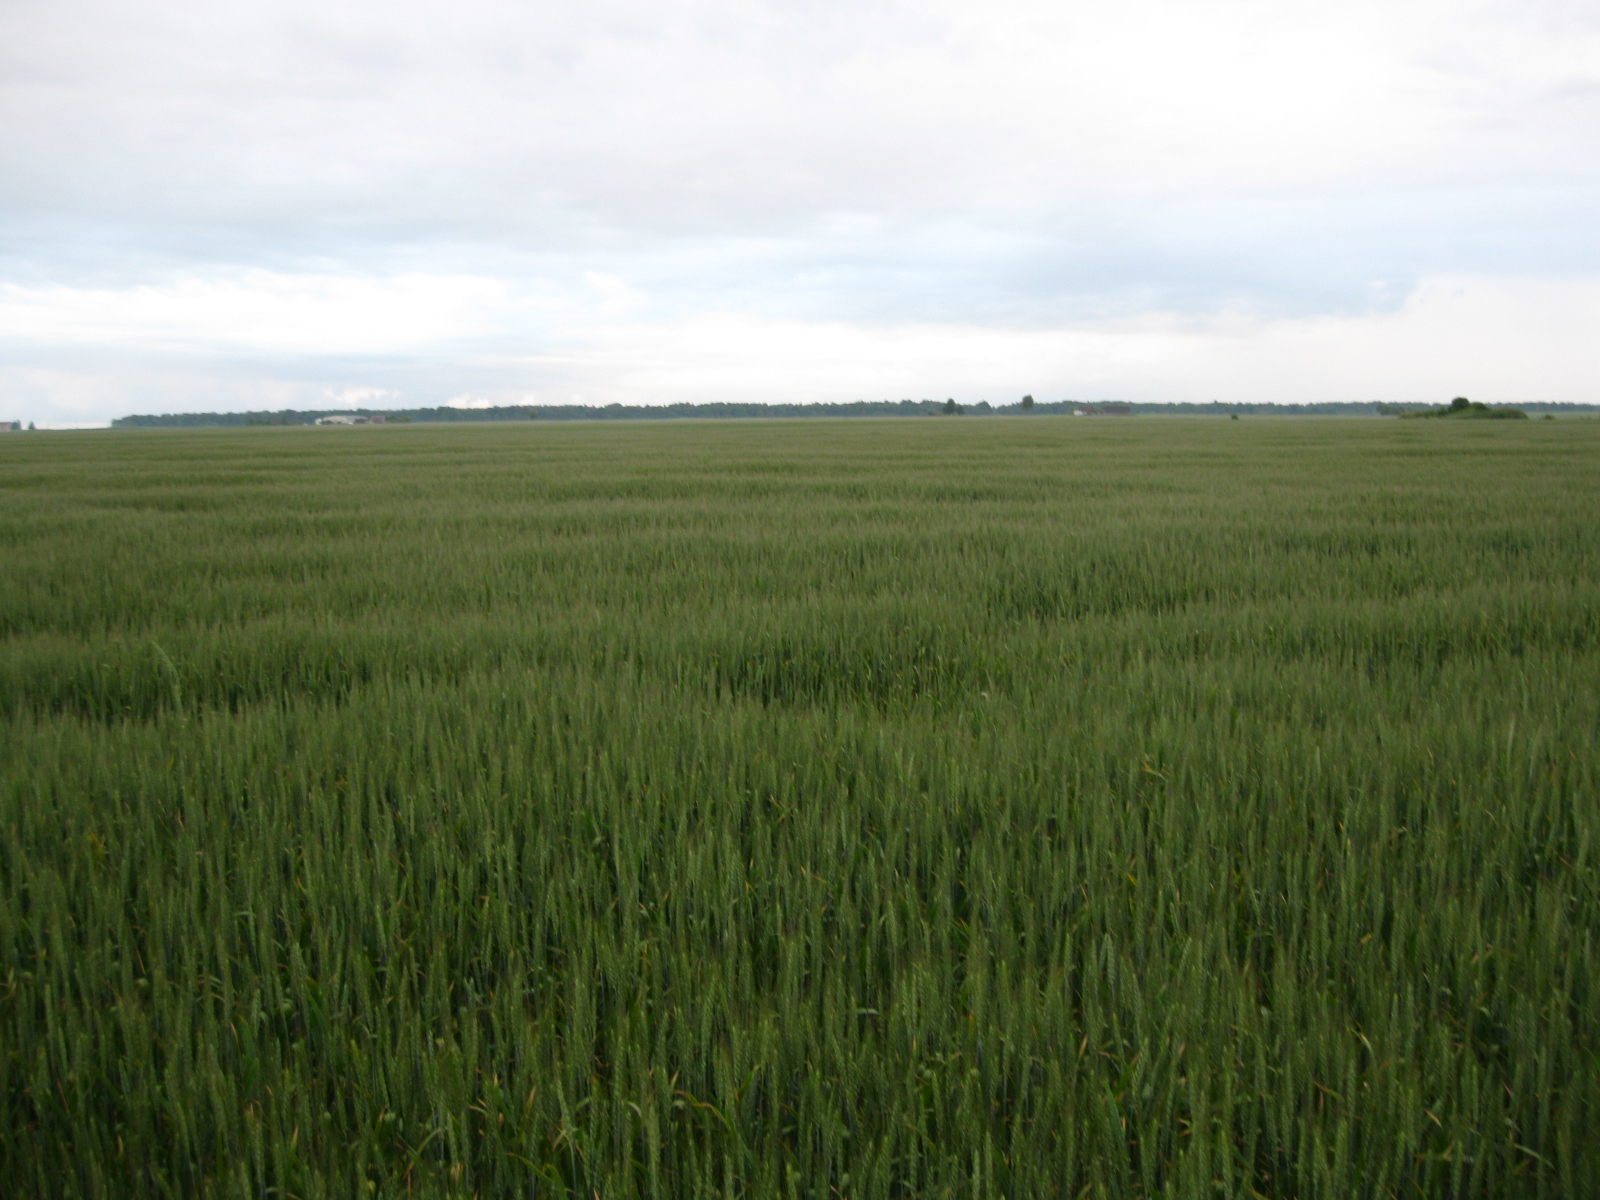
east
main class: Cropland
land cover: Durum wheat
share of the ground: > 75 %
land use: Agriculture (excluding fallow land and kitchen gardens)
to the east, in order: Durum wheat
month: June
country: LT
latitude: 55.4423
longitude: 23.9193
